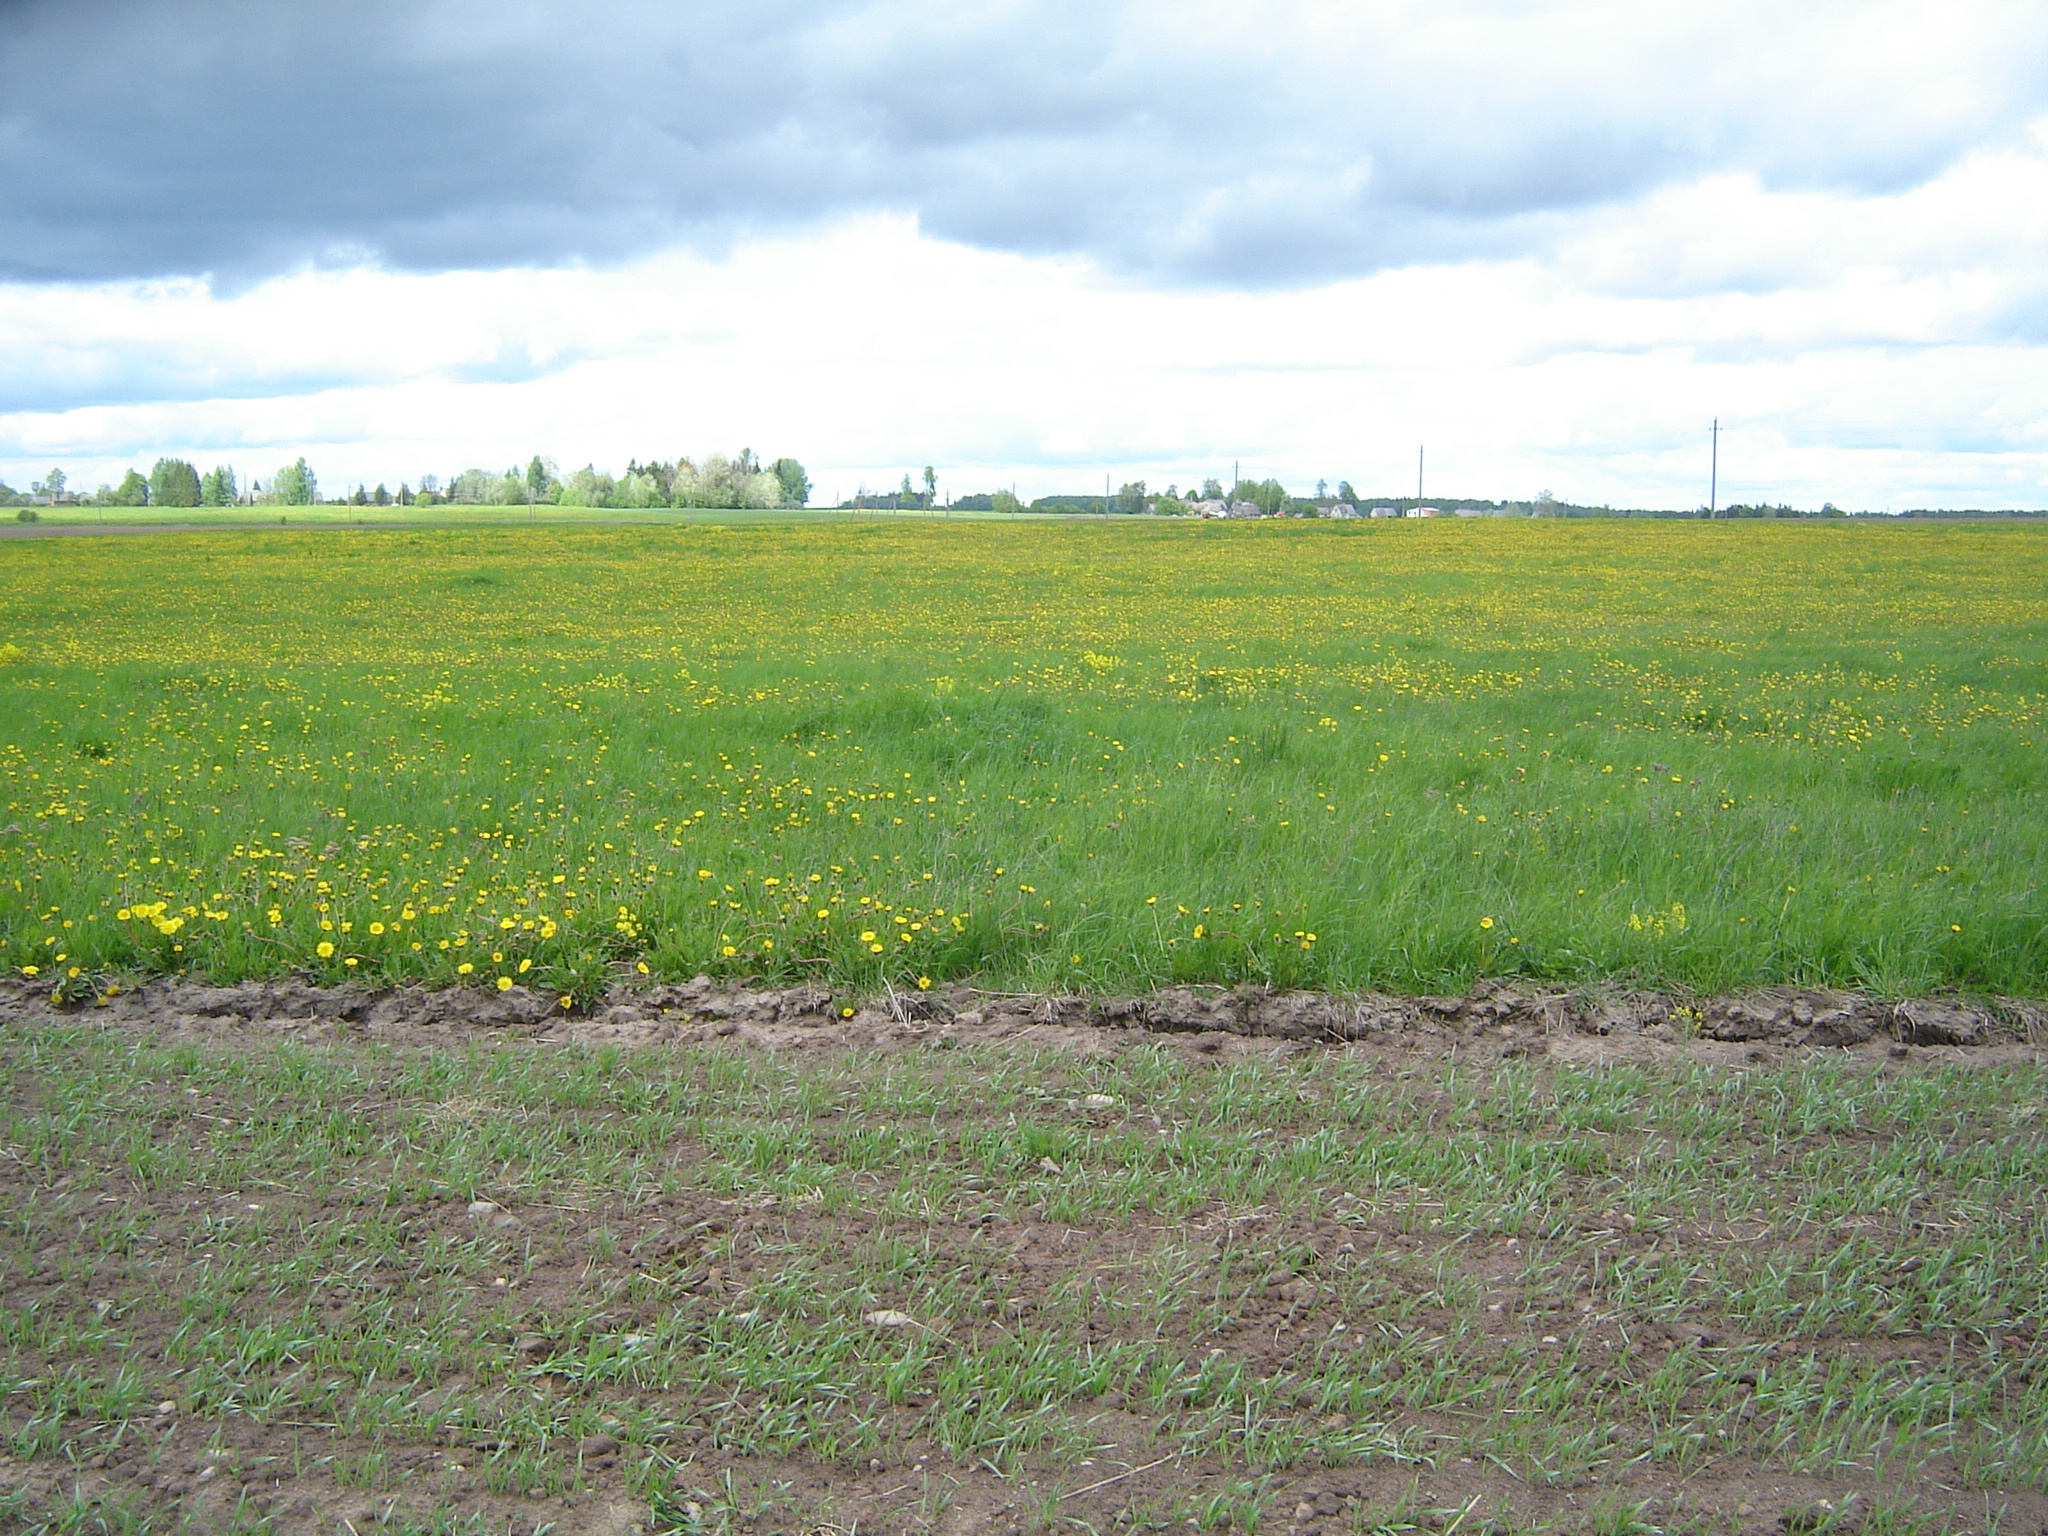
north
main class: Cropland
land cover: Barley
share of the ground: 25 - 50 %
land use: Agriculture (excluding fallow land and kitchen gardens)
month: May
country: LT
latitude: 56.0171
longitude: 25.2761
